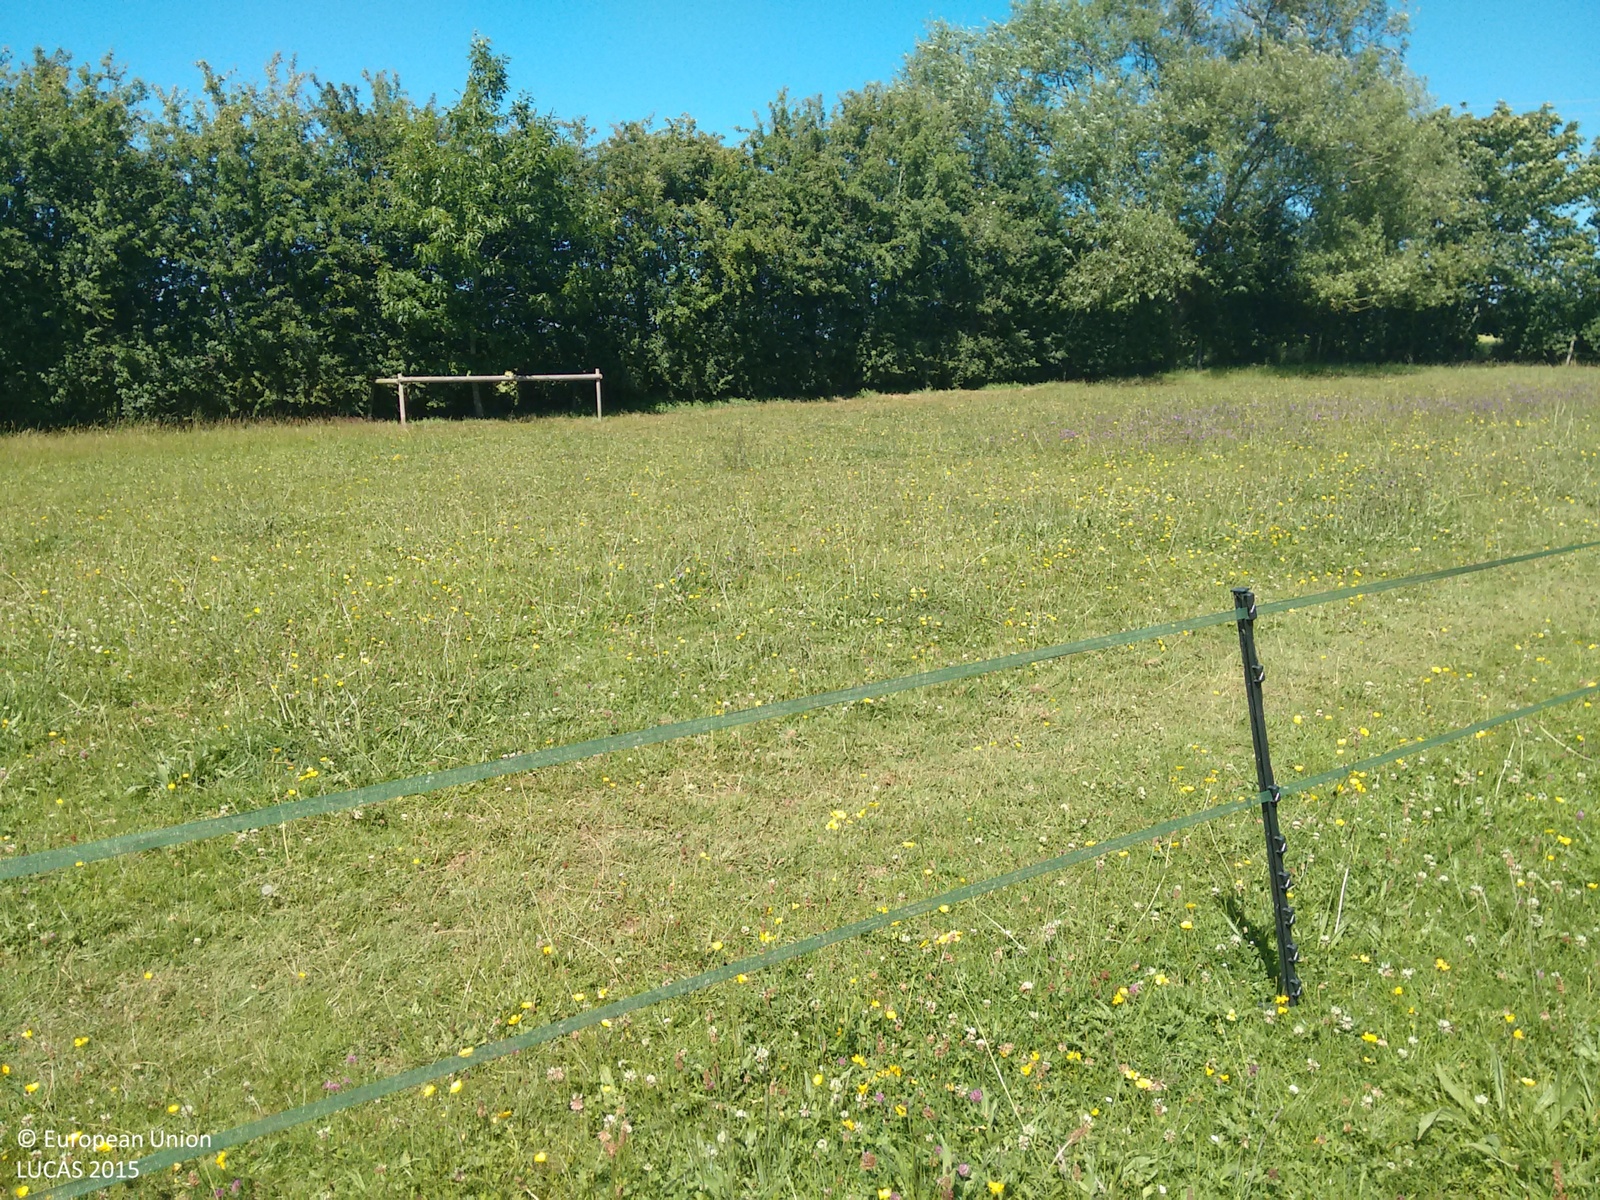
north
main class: Grassland
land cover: Grassland without tree/shrub cover
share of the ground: > 75 %
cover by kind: herbaceous plants 100 %
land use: Agriculture (excluding fallow land and kitchen gardens)
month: June
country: GB
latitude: 52.0784
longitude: -2.6615
